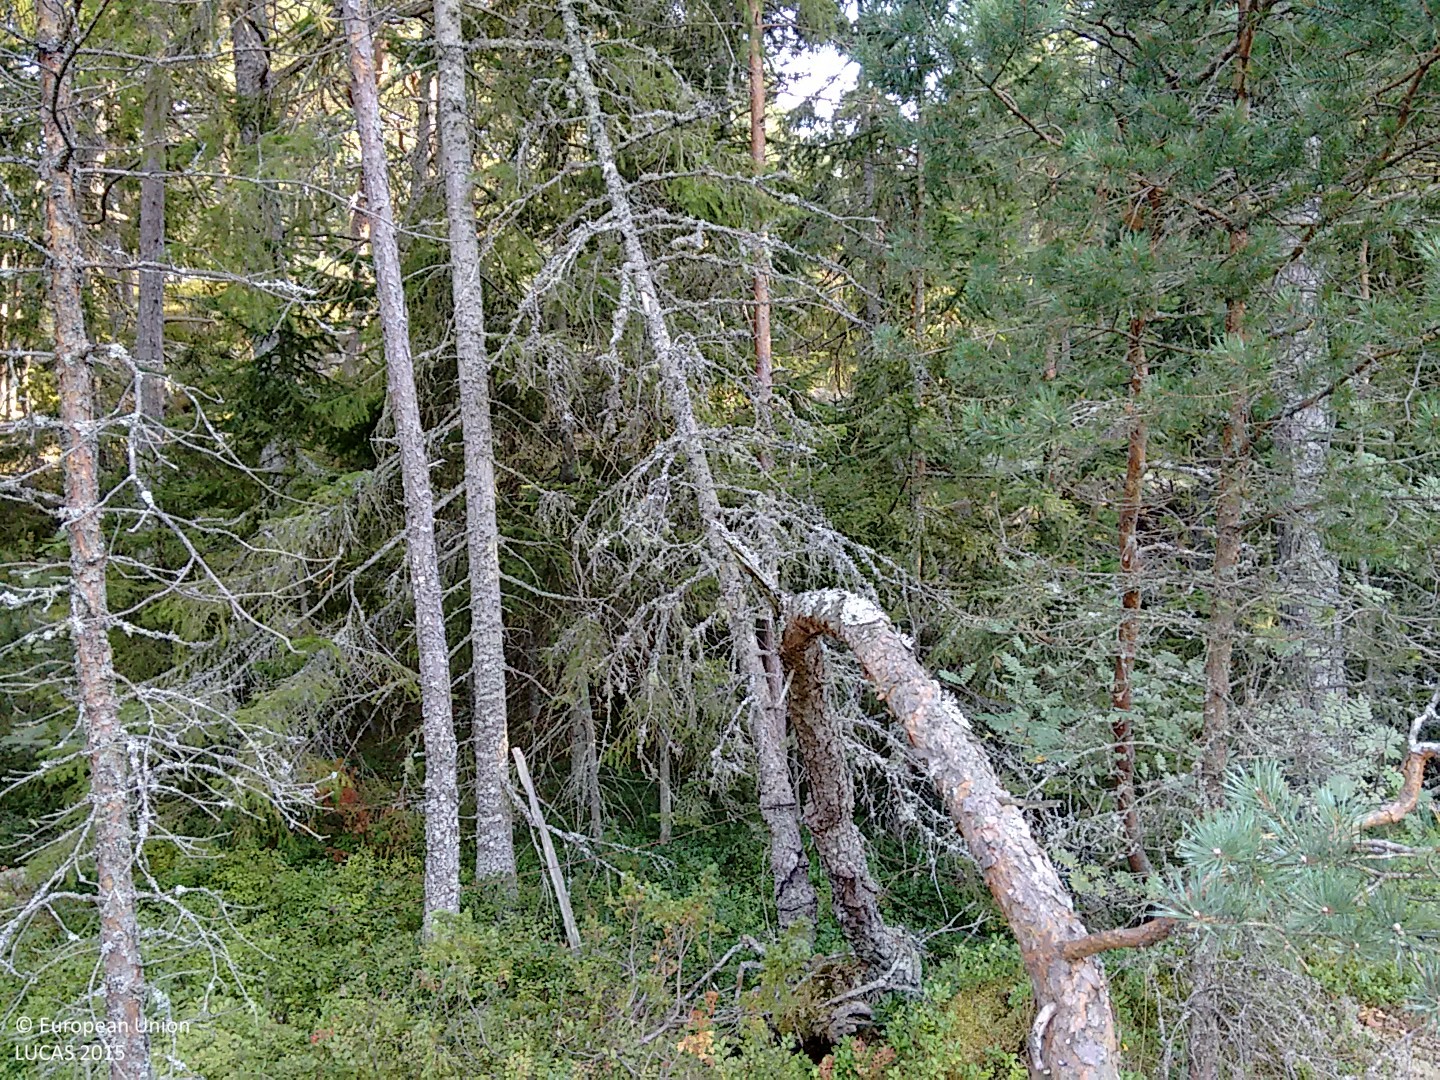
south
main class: Woodland
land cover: Pine dominated coniferous woodland
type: hemiboreal forest and nemoral coniferous forest and mixed broadleaved-coniferous forest
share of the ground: 50 - 75 %
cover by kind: coniferous forest trees 70 %, lichens and mosses 20 %, shrubs 10 %
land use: Forestry
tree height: > 5 m
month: August
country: FI
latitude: 60.0235
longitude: 20.5092
